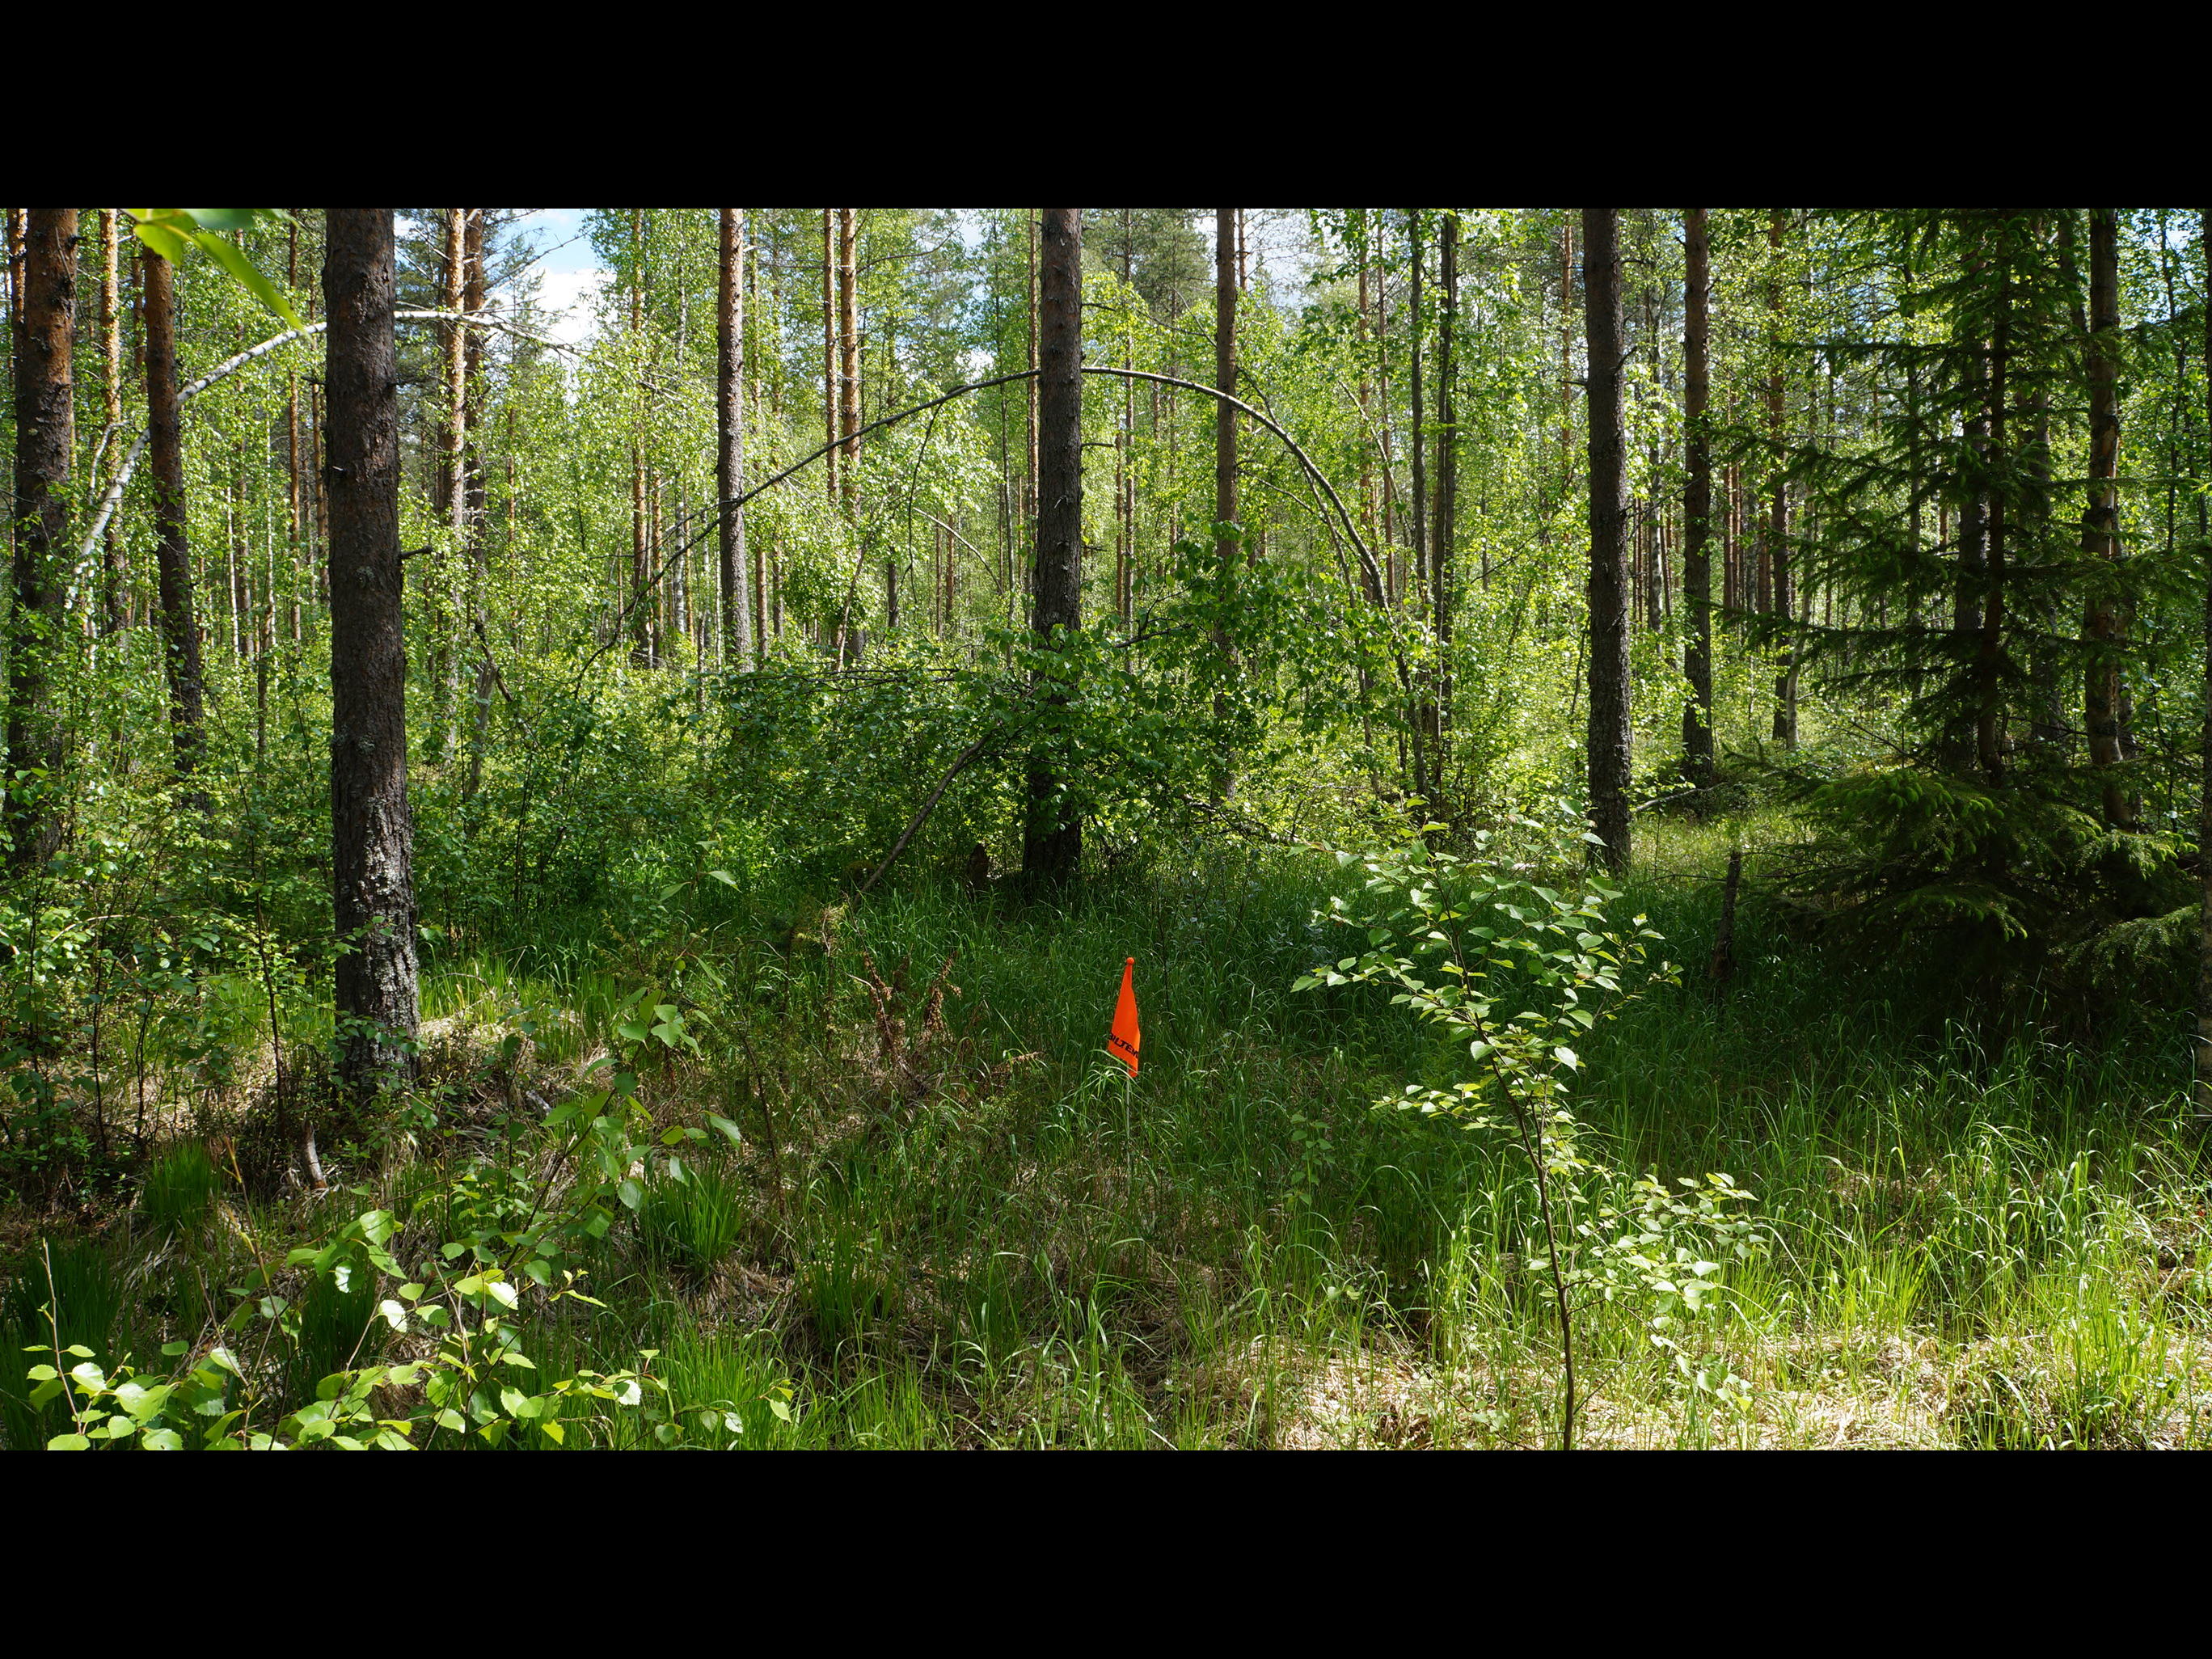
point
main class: Woodland
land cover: Pine dominated mixed woodland
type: boreal forest
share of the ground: > 75 %
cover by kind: coniferous forest trees 50 %, broadleaved forest trees 25 %, shrubs 10 %, herbaceous plants 10 %, lichens and mosses 5 %
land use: Forestry
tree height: > 5 m
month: June
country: FI
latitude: 64.1057
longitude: 25.1719
